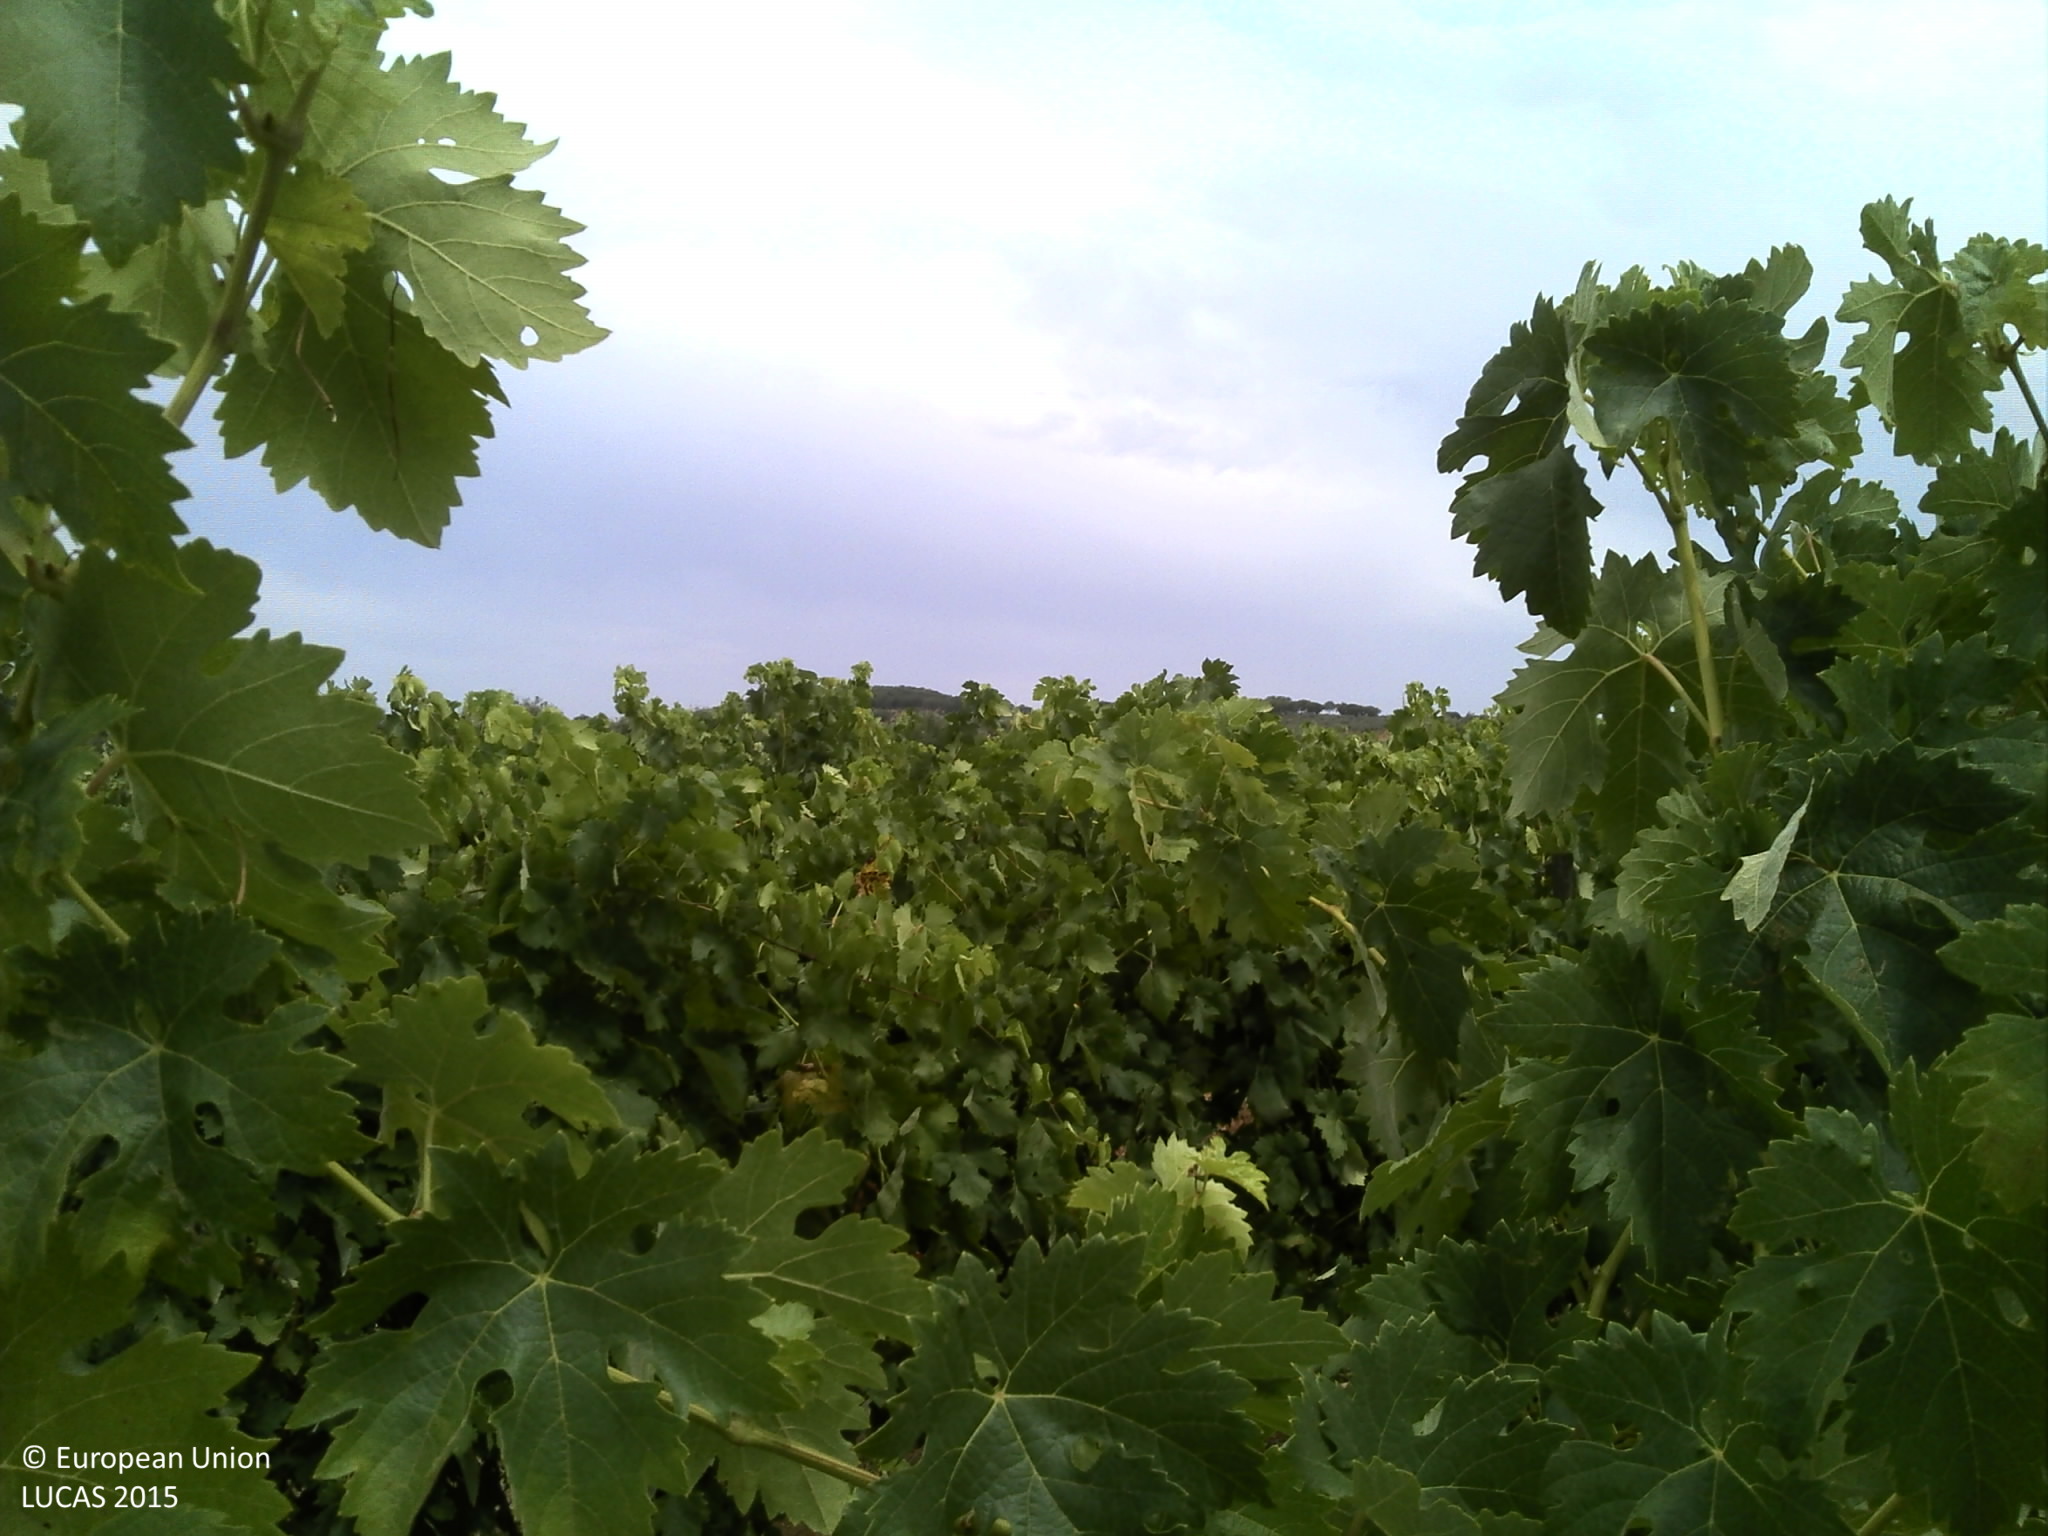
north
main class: Cropland
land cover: Vineyards
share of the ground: 25 - 50 %
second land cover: Other bare soil
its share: > 75 %
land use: Agriculture (excluding fallow land and kitchen gardens)
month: July
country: PT
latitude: 38.8226
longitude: -7.5311
